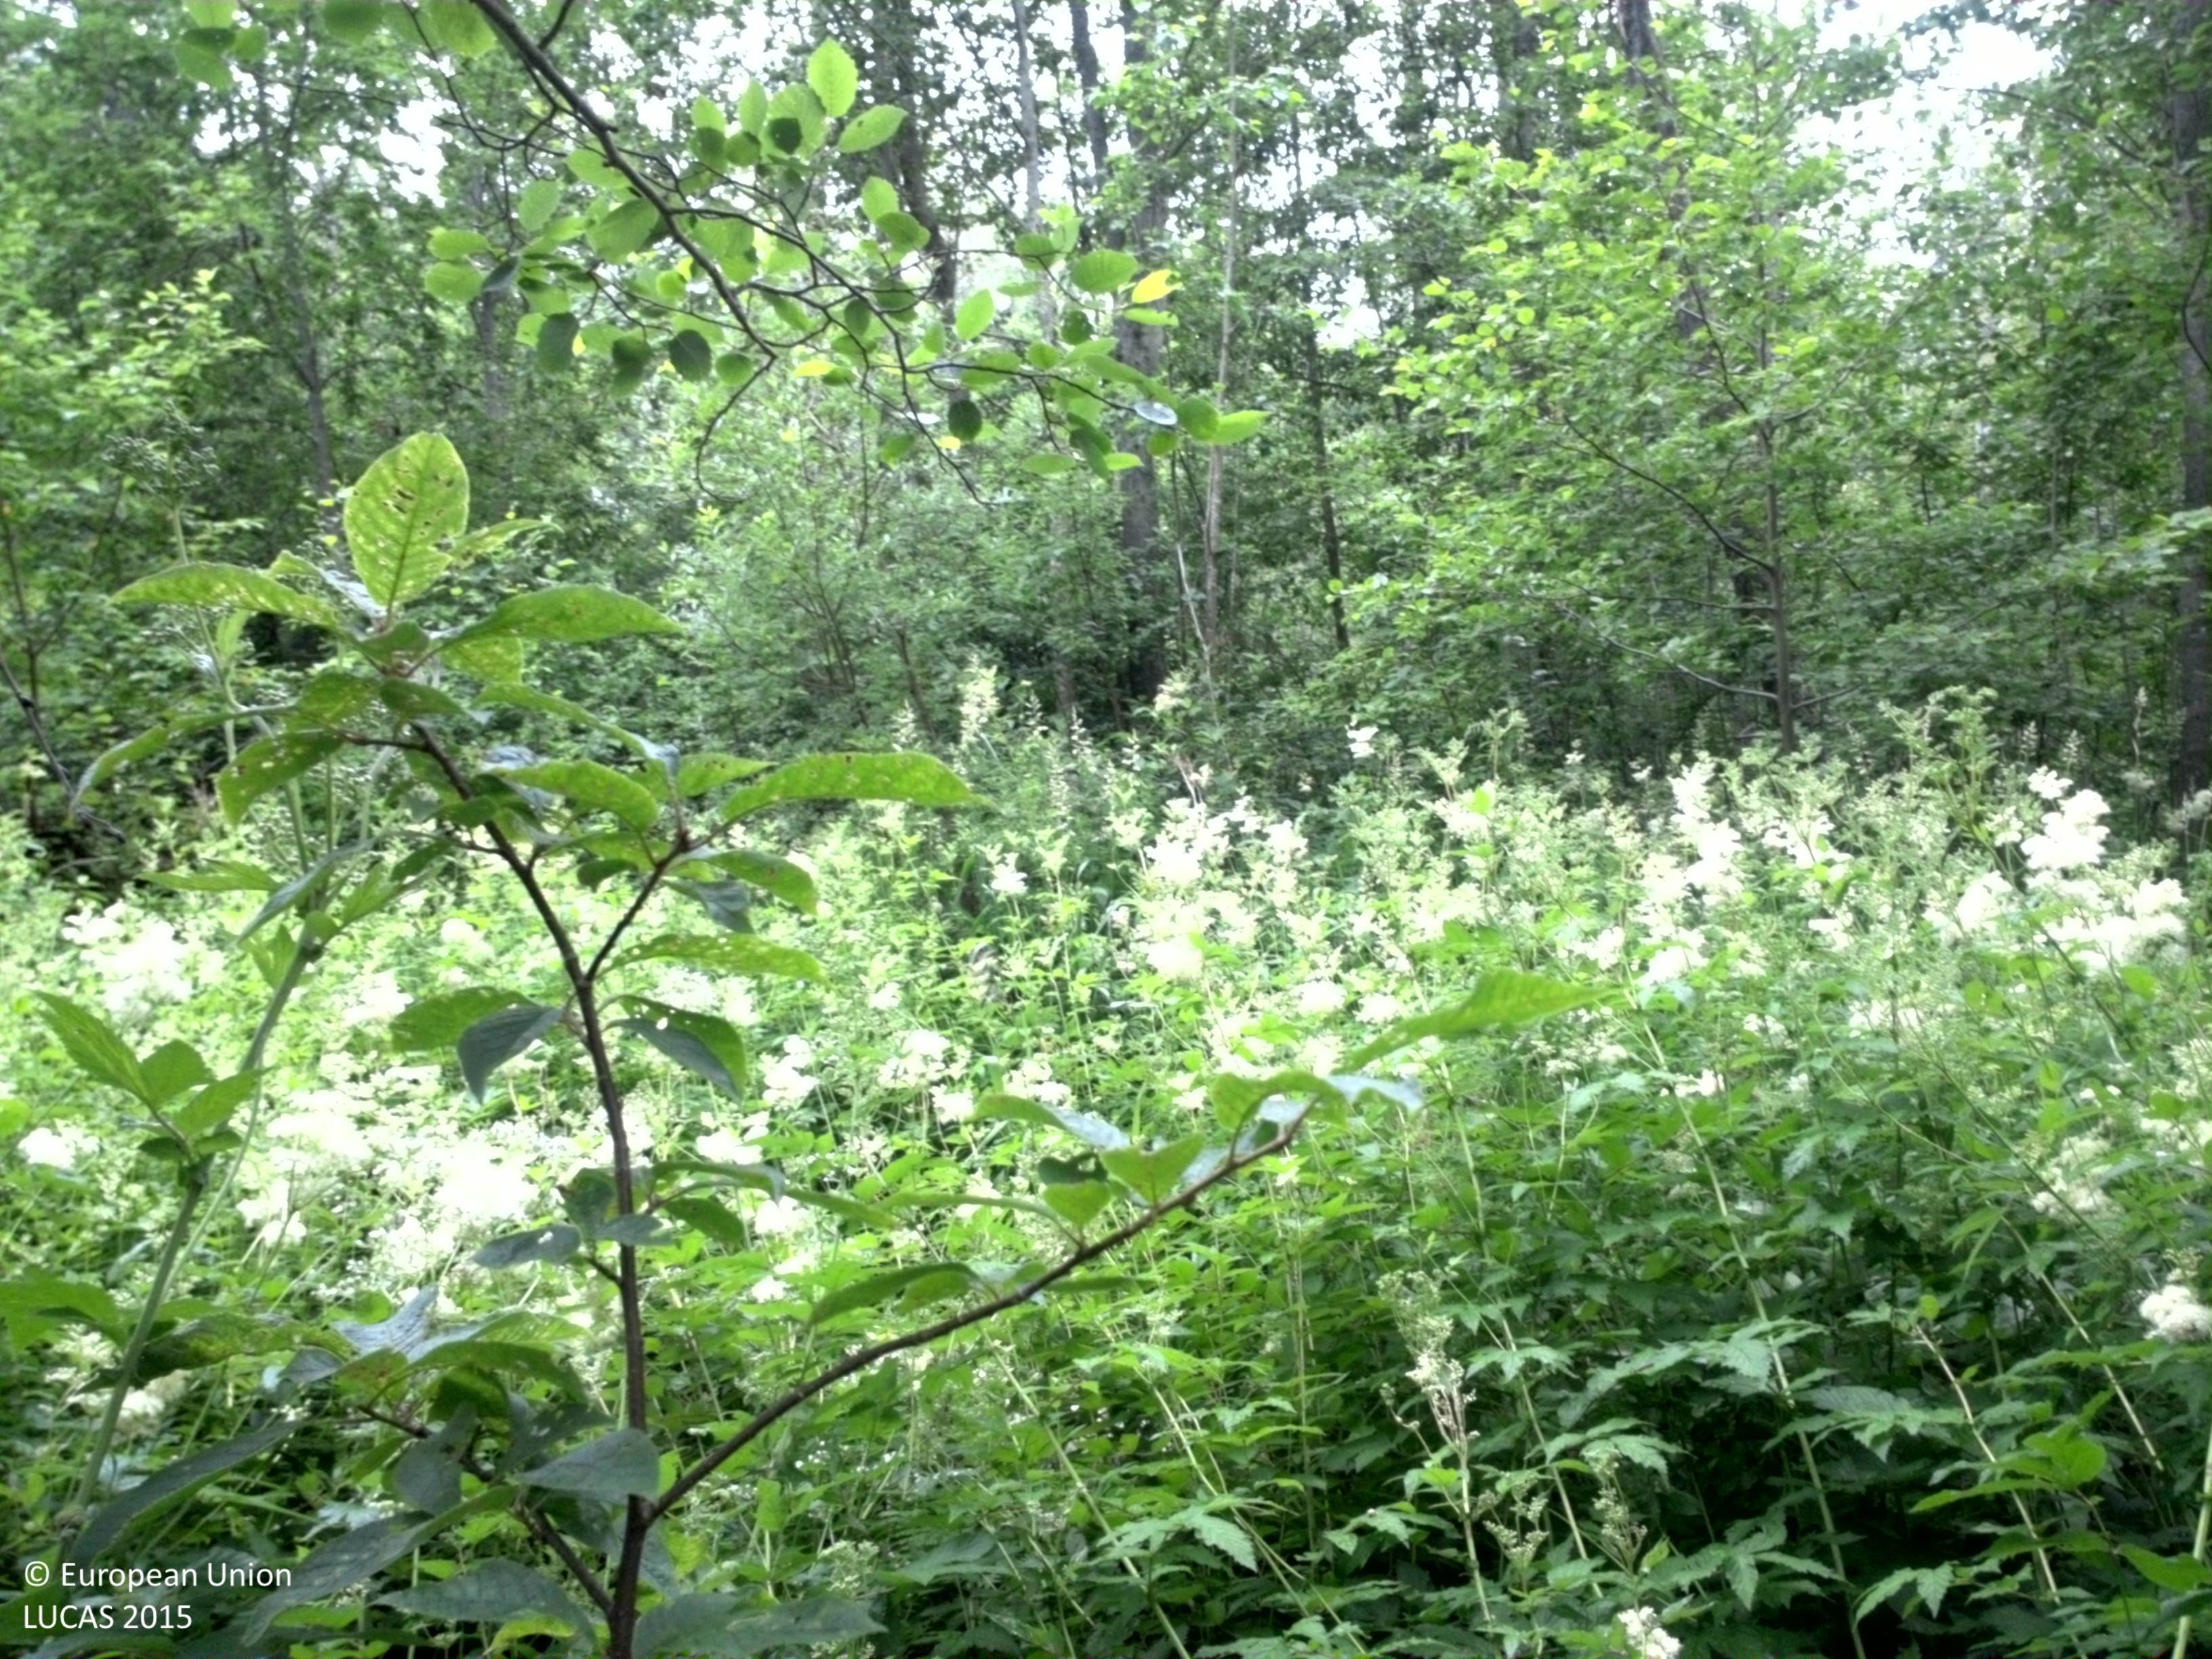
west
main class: Woodland
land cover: Broadleaved woodland
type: boreal forest
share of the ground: 50 - 75 %
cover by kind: broadleaved forest trees 60 %, shrubs 30 %, herbaceous plants 10 %
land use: Forestry
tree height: > 5 m
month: July
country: SE
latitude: 59.3904
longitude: 12.1250
